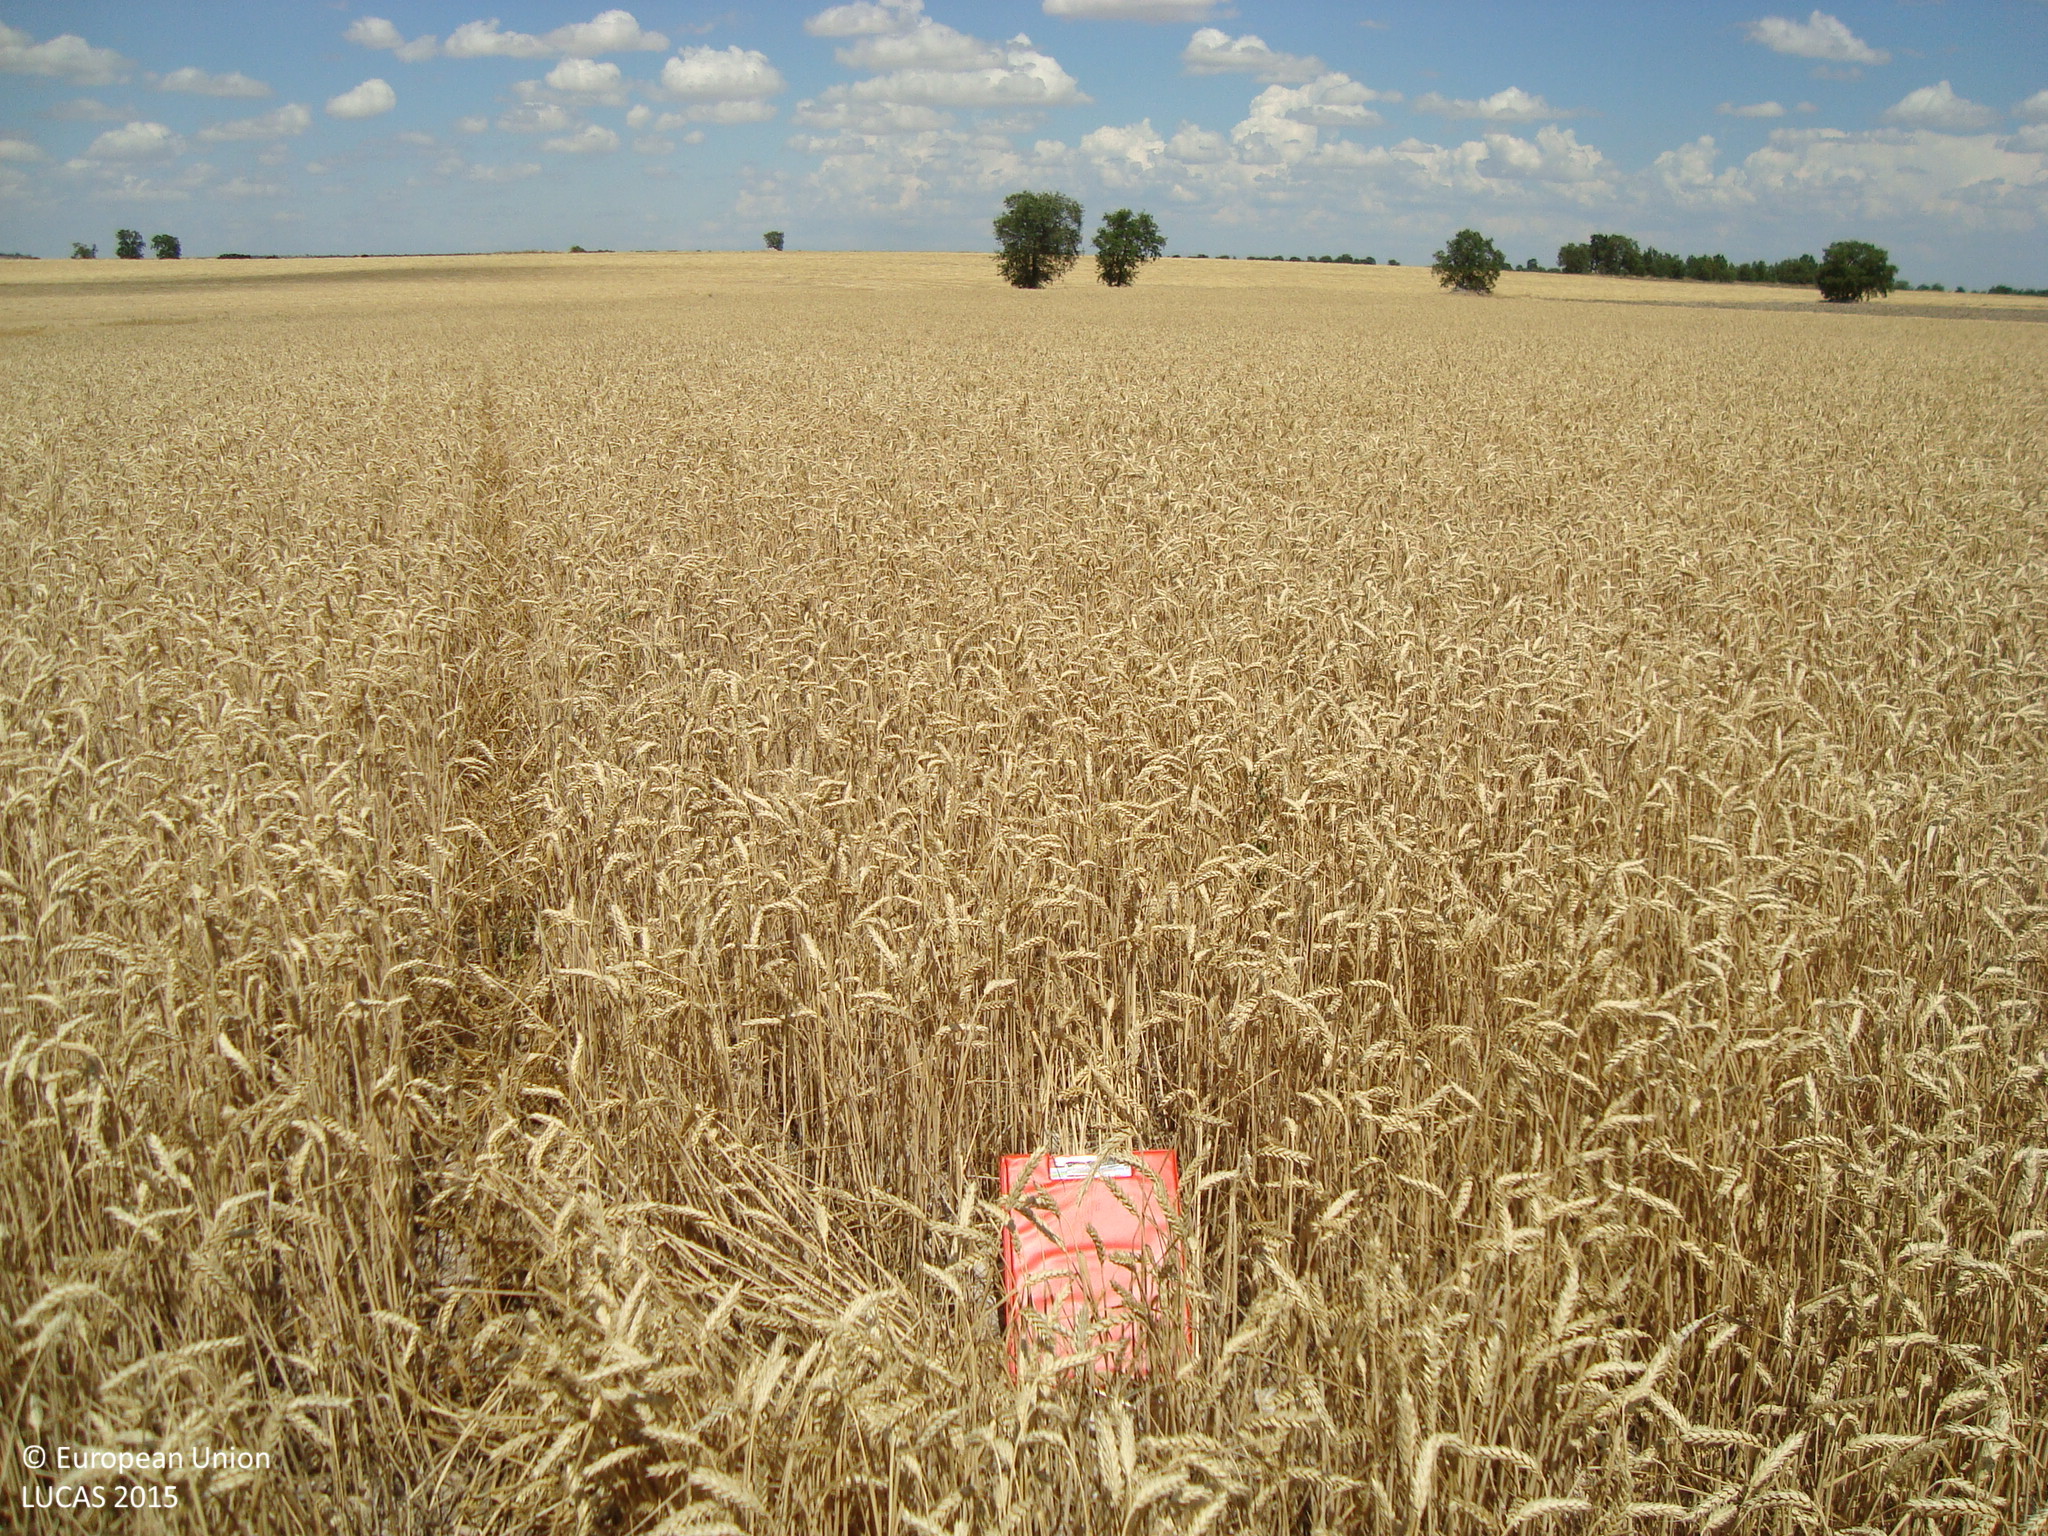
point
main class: Cropland
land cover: Common wheat
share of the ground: > 75 %
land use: Agriculture (excluding fallow land and kitchen gardens)
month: July
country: ES
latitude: 41.7433
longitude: -4.0436
